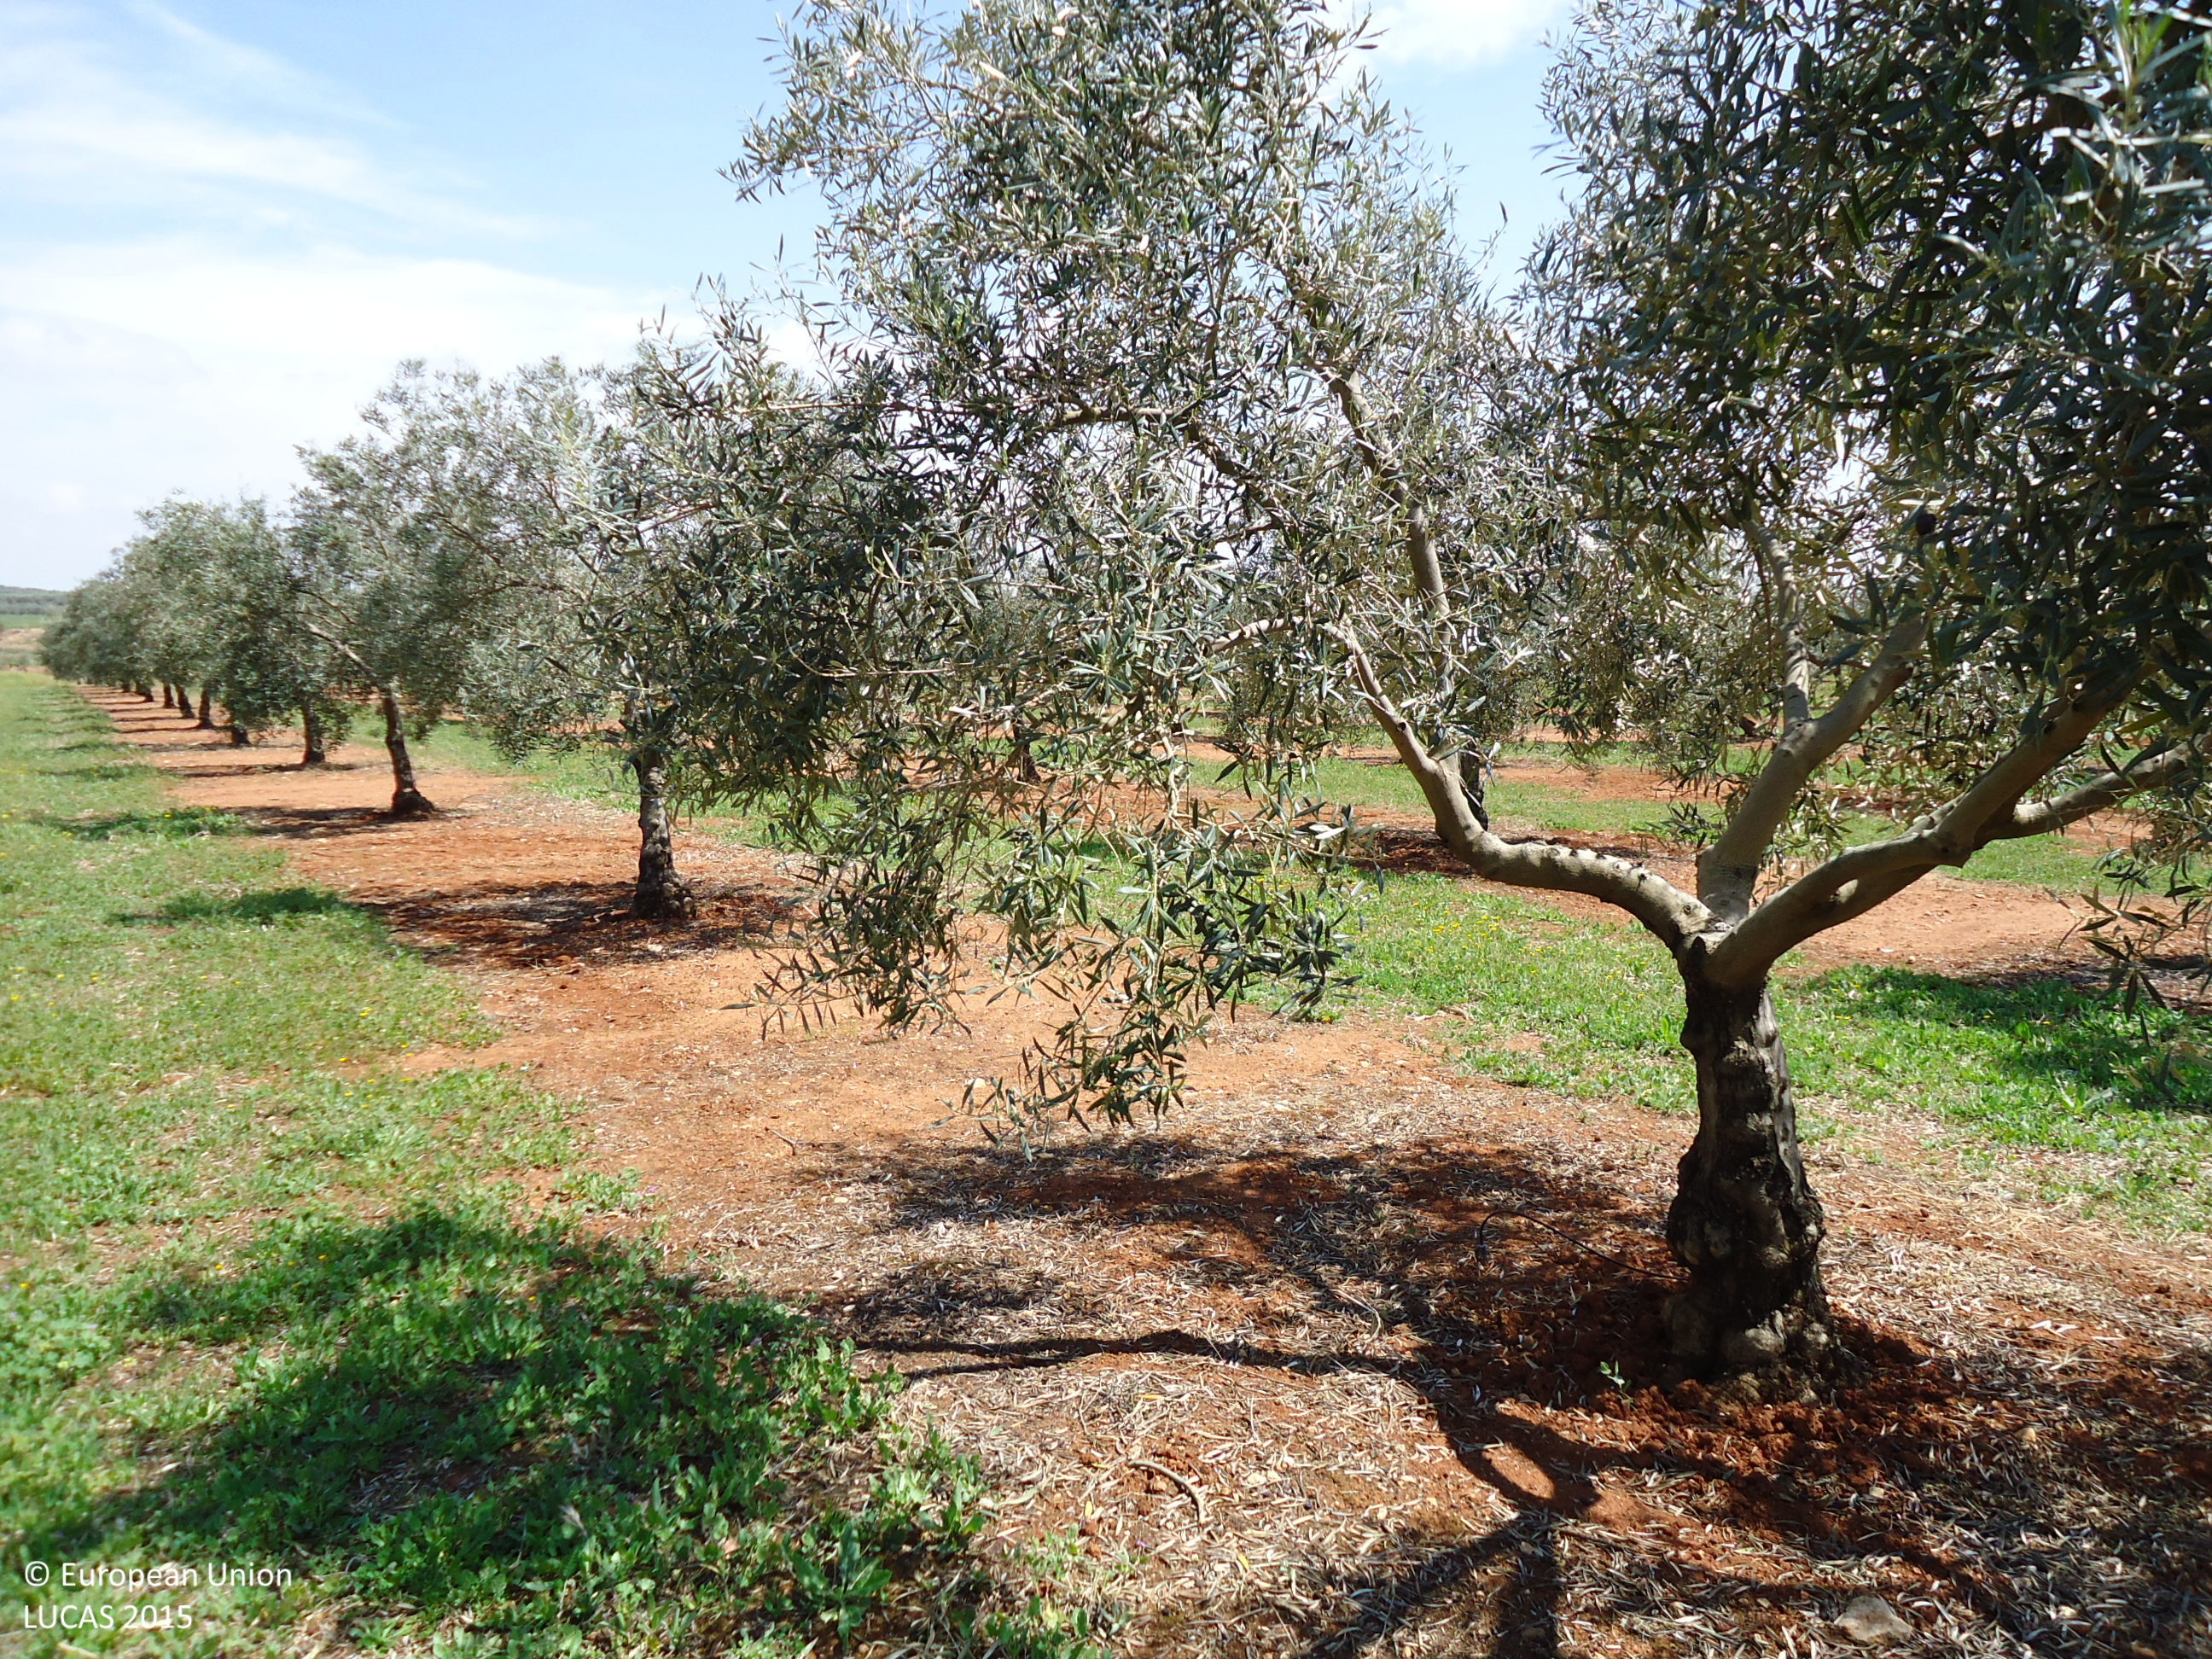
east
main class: Cropland
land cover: Olive groves
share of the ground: 25 - 50 %
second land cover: Spontaneously vegetated surfaces
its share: 50 - 75 %
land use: Agriculture (excluding fallow land and kitchen gardens)
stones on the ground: < 10 %
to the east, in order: Olive groves; Spontaneously vegetated surfaces
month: April
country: ES
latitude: 37.0735
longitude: -4.8370
